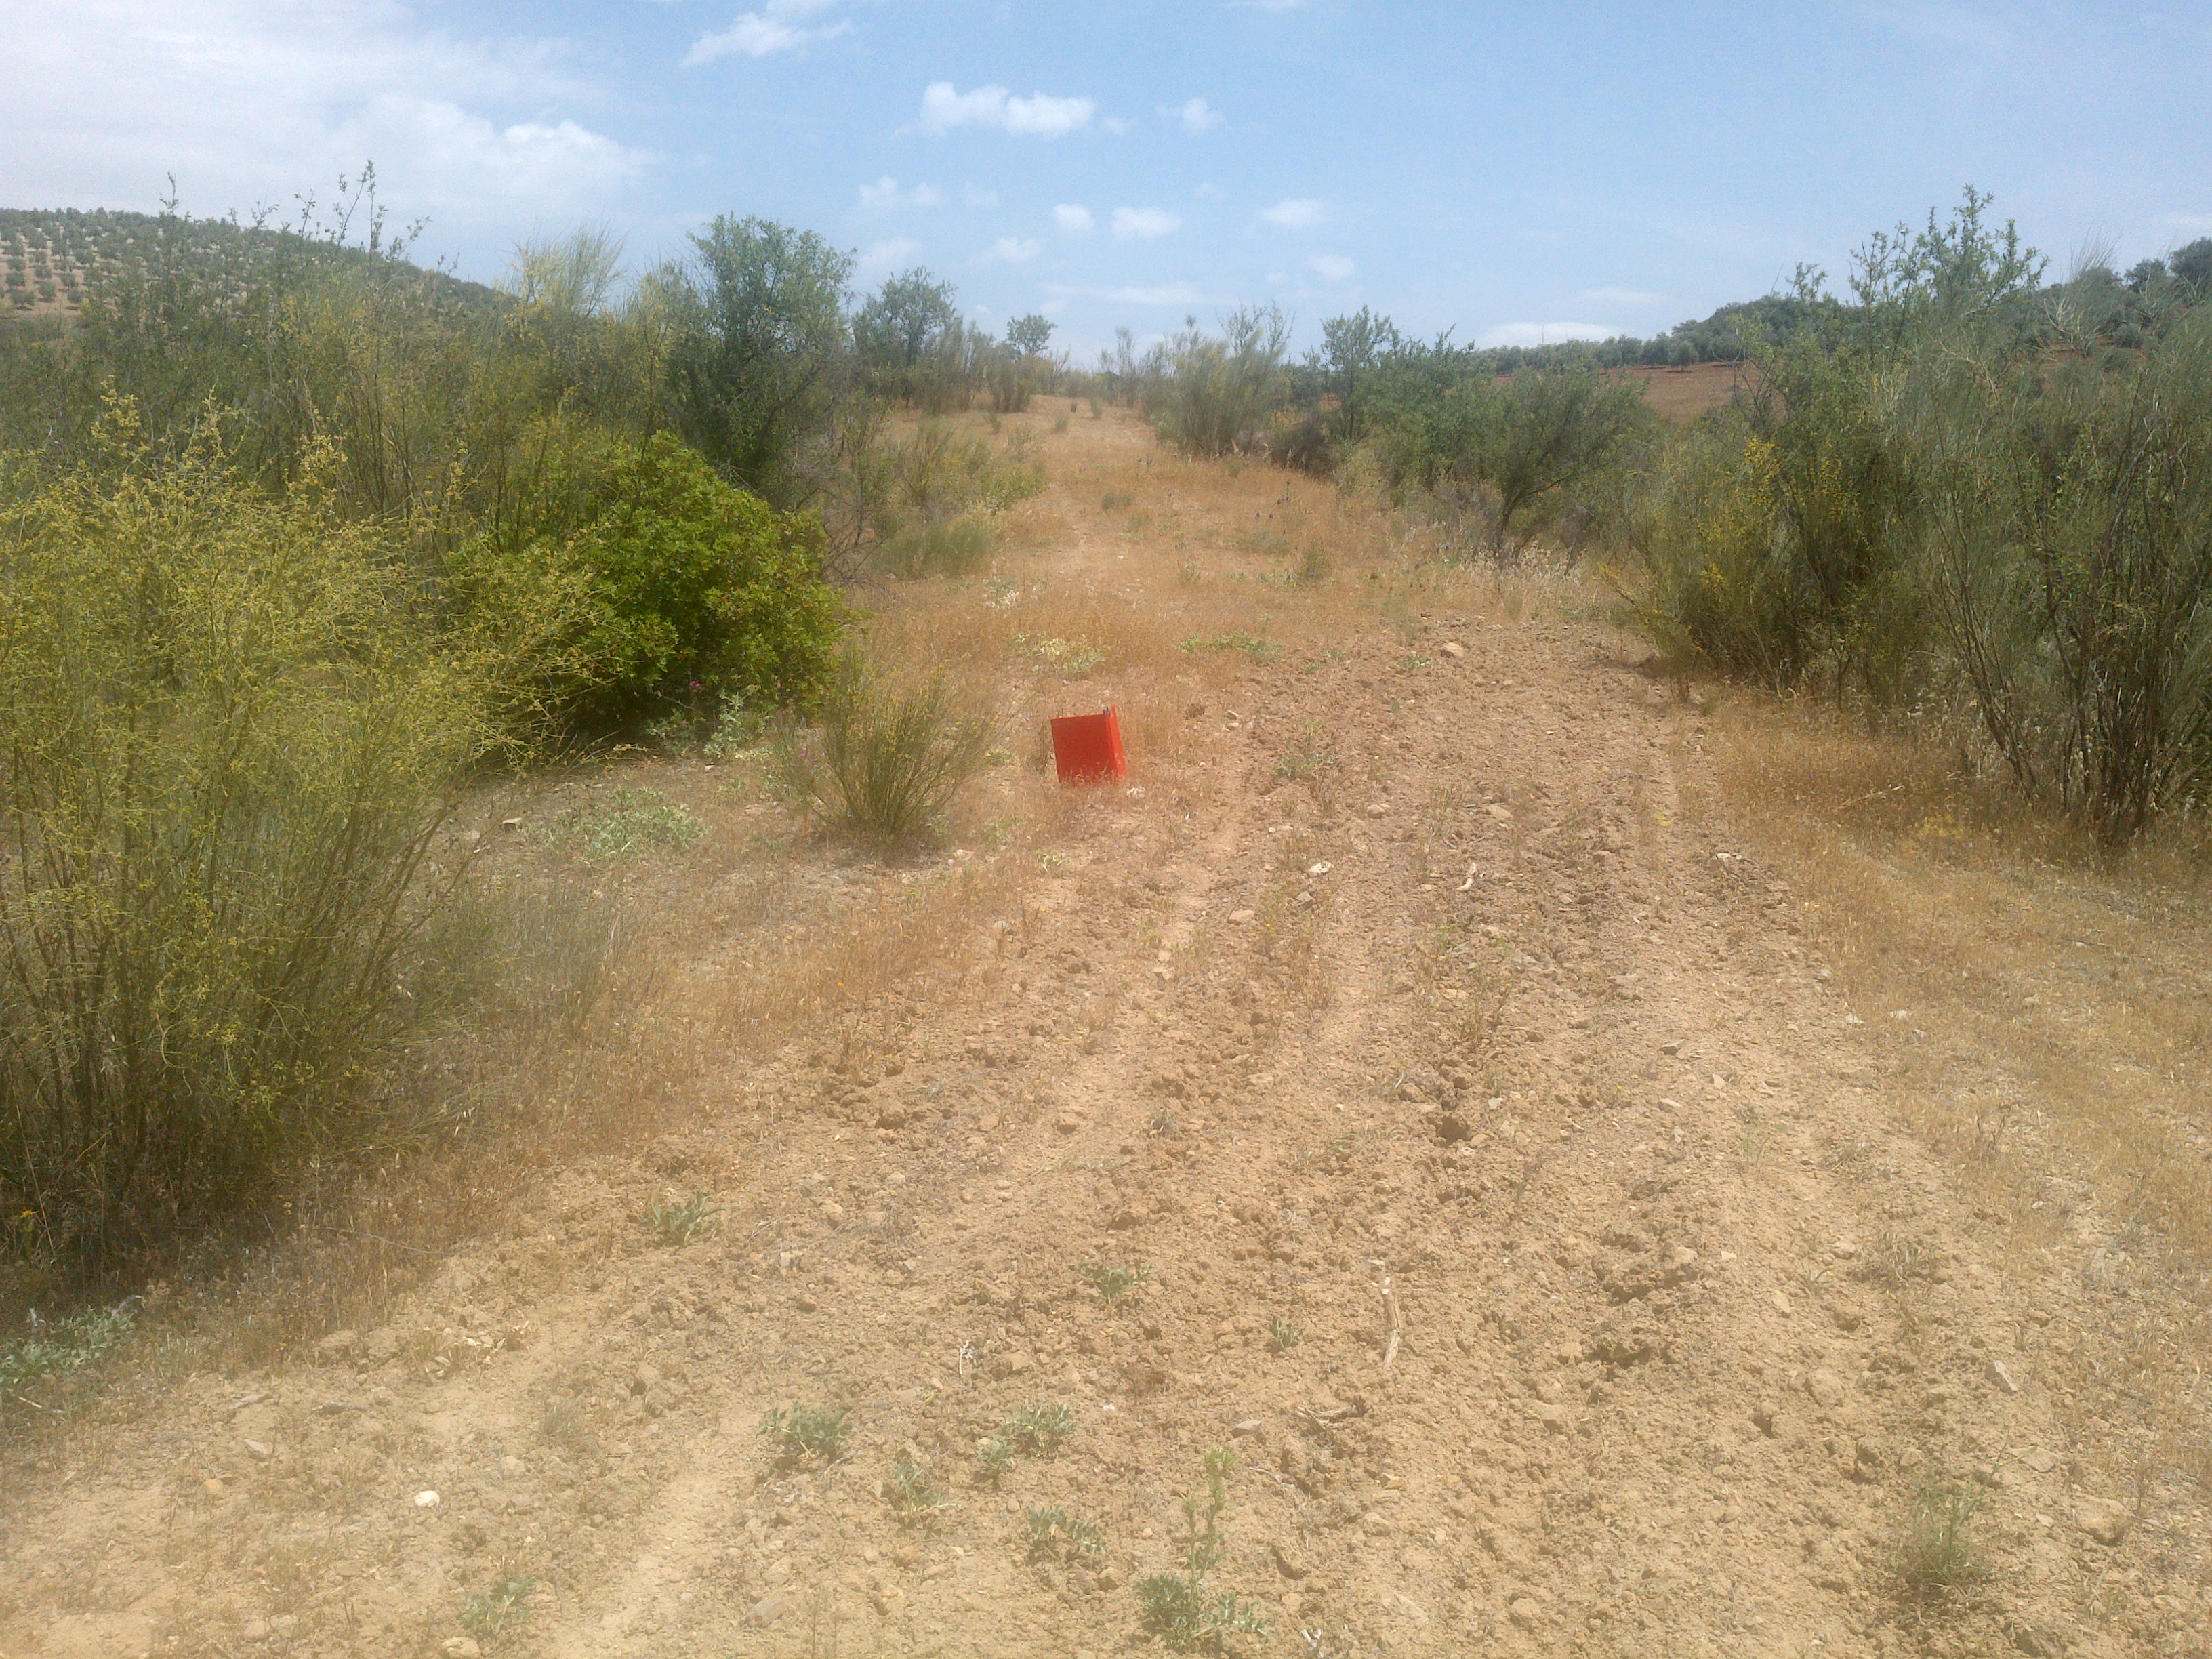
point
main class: Shrubland
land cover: Shrubland without tree cover
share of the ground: 25 - 50 %
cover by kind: herbaceous plants 50 %, shrubs 25 %, unconsolidated bare surface 25 %
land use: Semi-natural and natural areas not in use
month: May
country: ES
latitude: 37.4823
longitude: -4.2159
